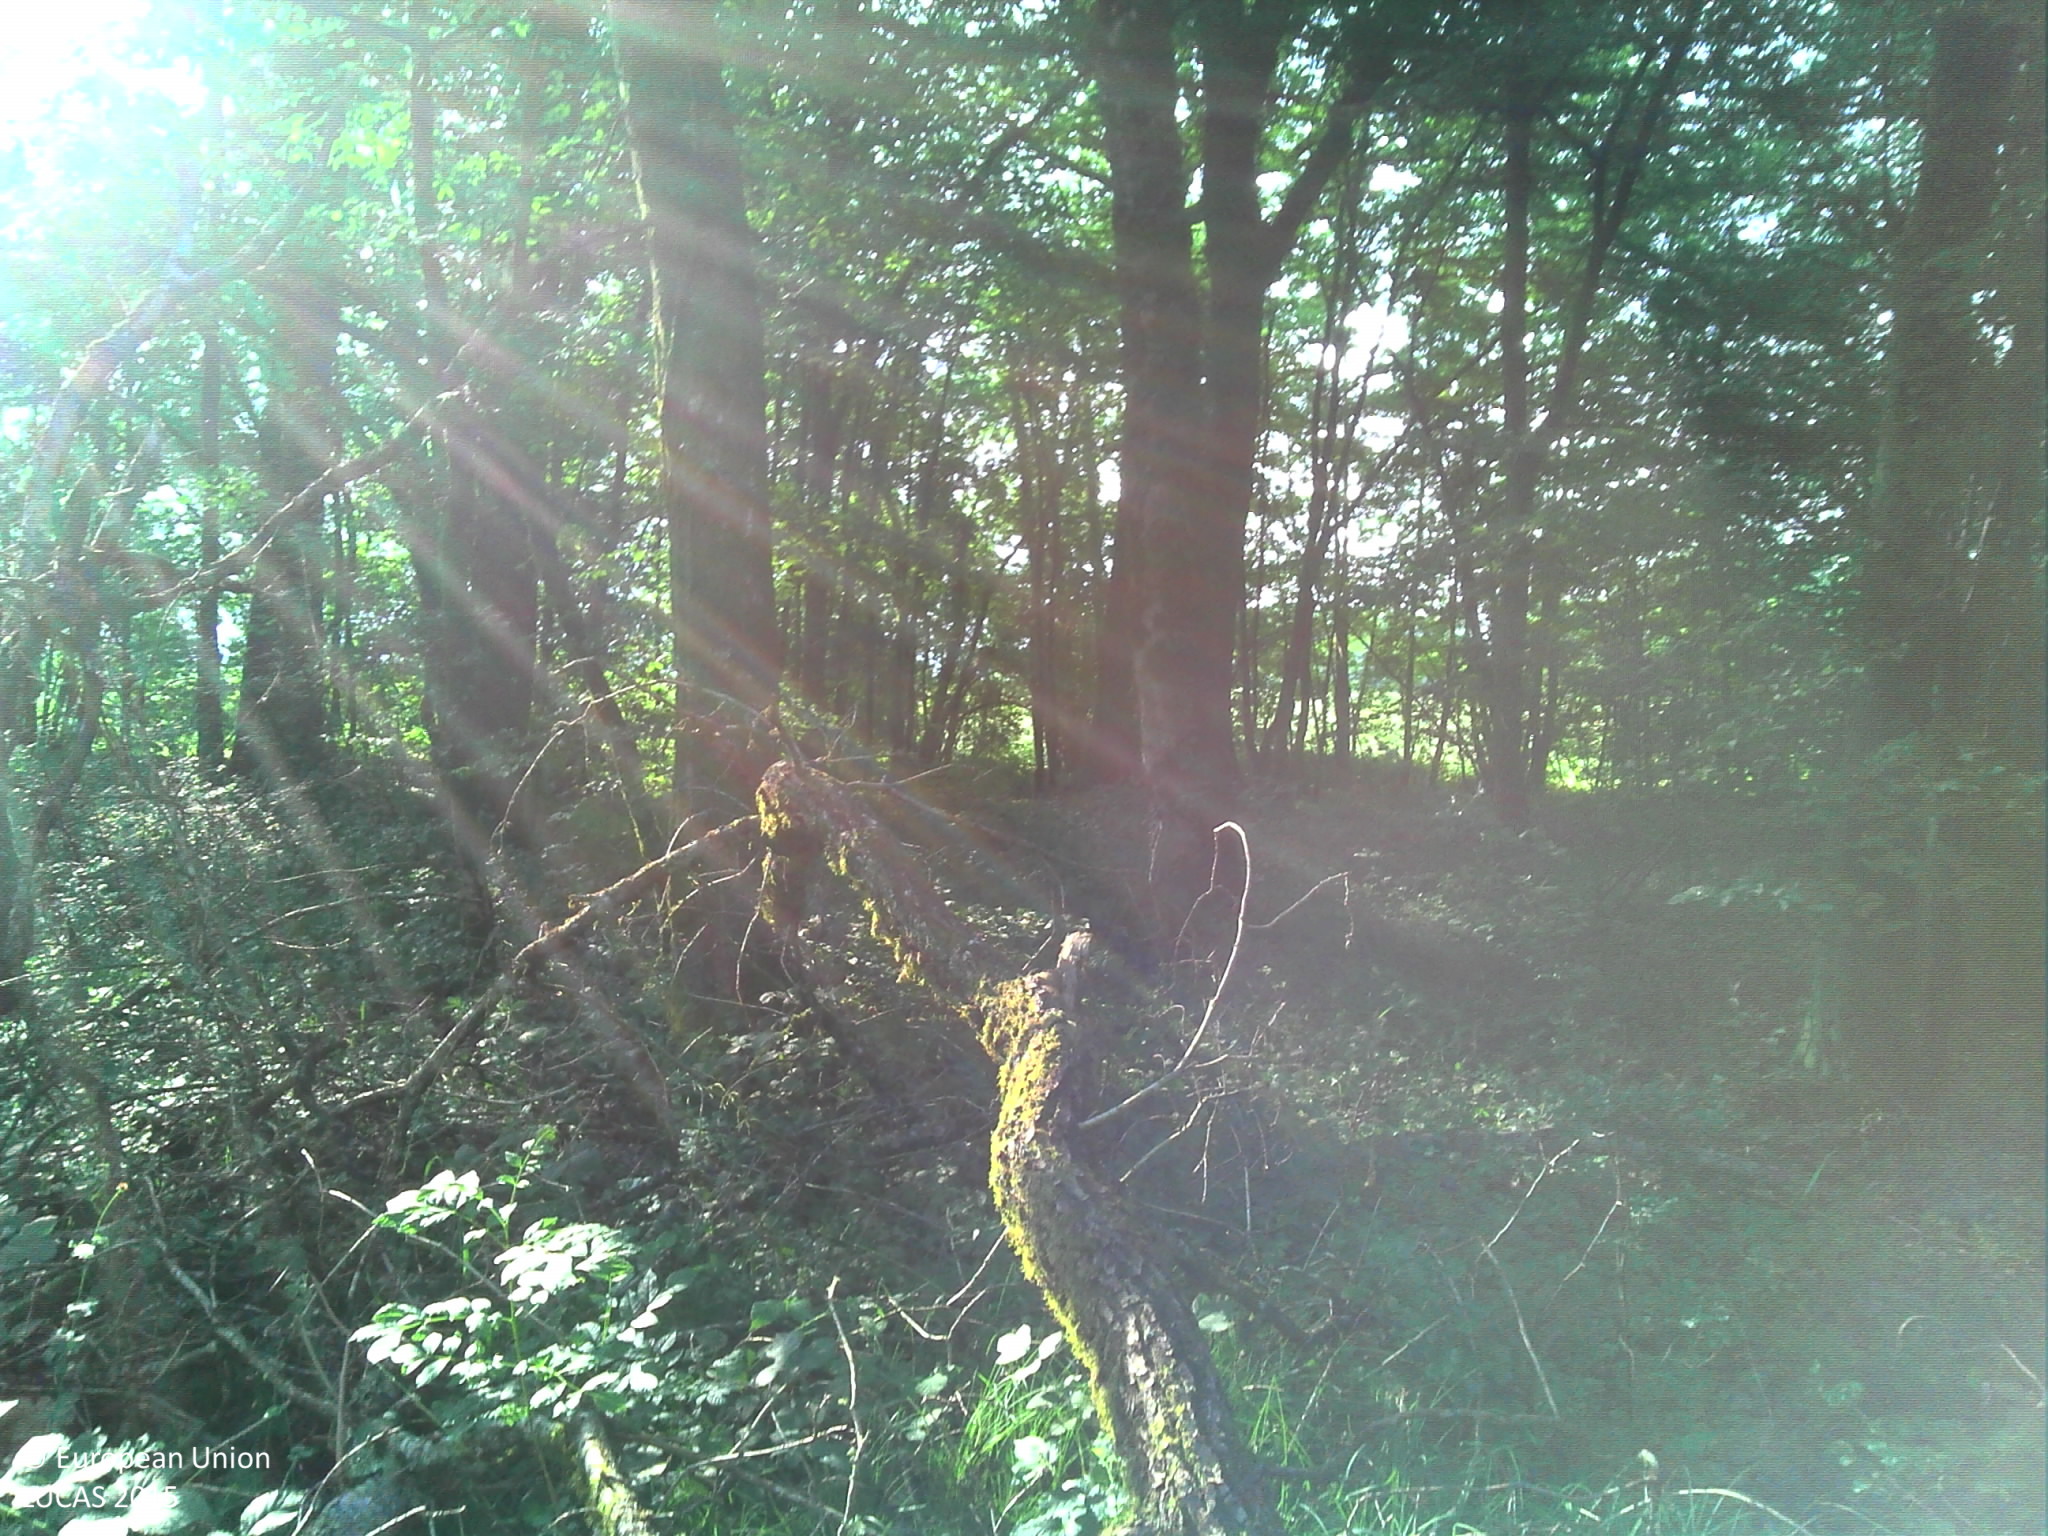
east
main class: Woodland
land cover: Broadleaved woodland
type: mesophytic deciduous forest
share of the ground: > 75 %
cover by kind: broadleaved forest trees 95 %, herbaceous plants 5 %
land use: Forestry
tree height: > 5 m
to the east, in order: Broadleaved woodland; Rivers and streams; Grassland without tree/shrub cover; Common wheat
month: June
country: FR
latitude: 47.7958
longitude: 6.1428
